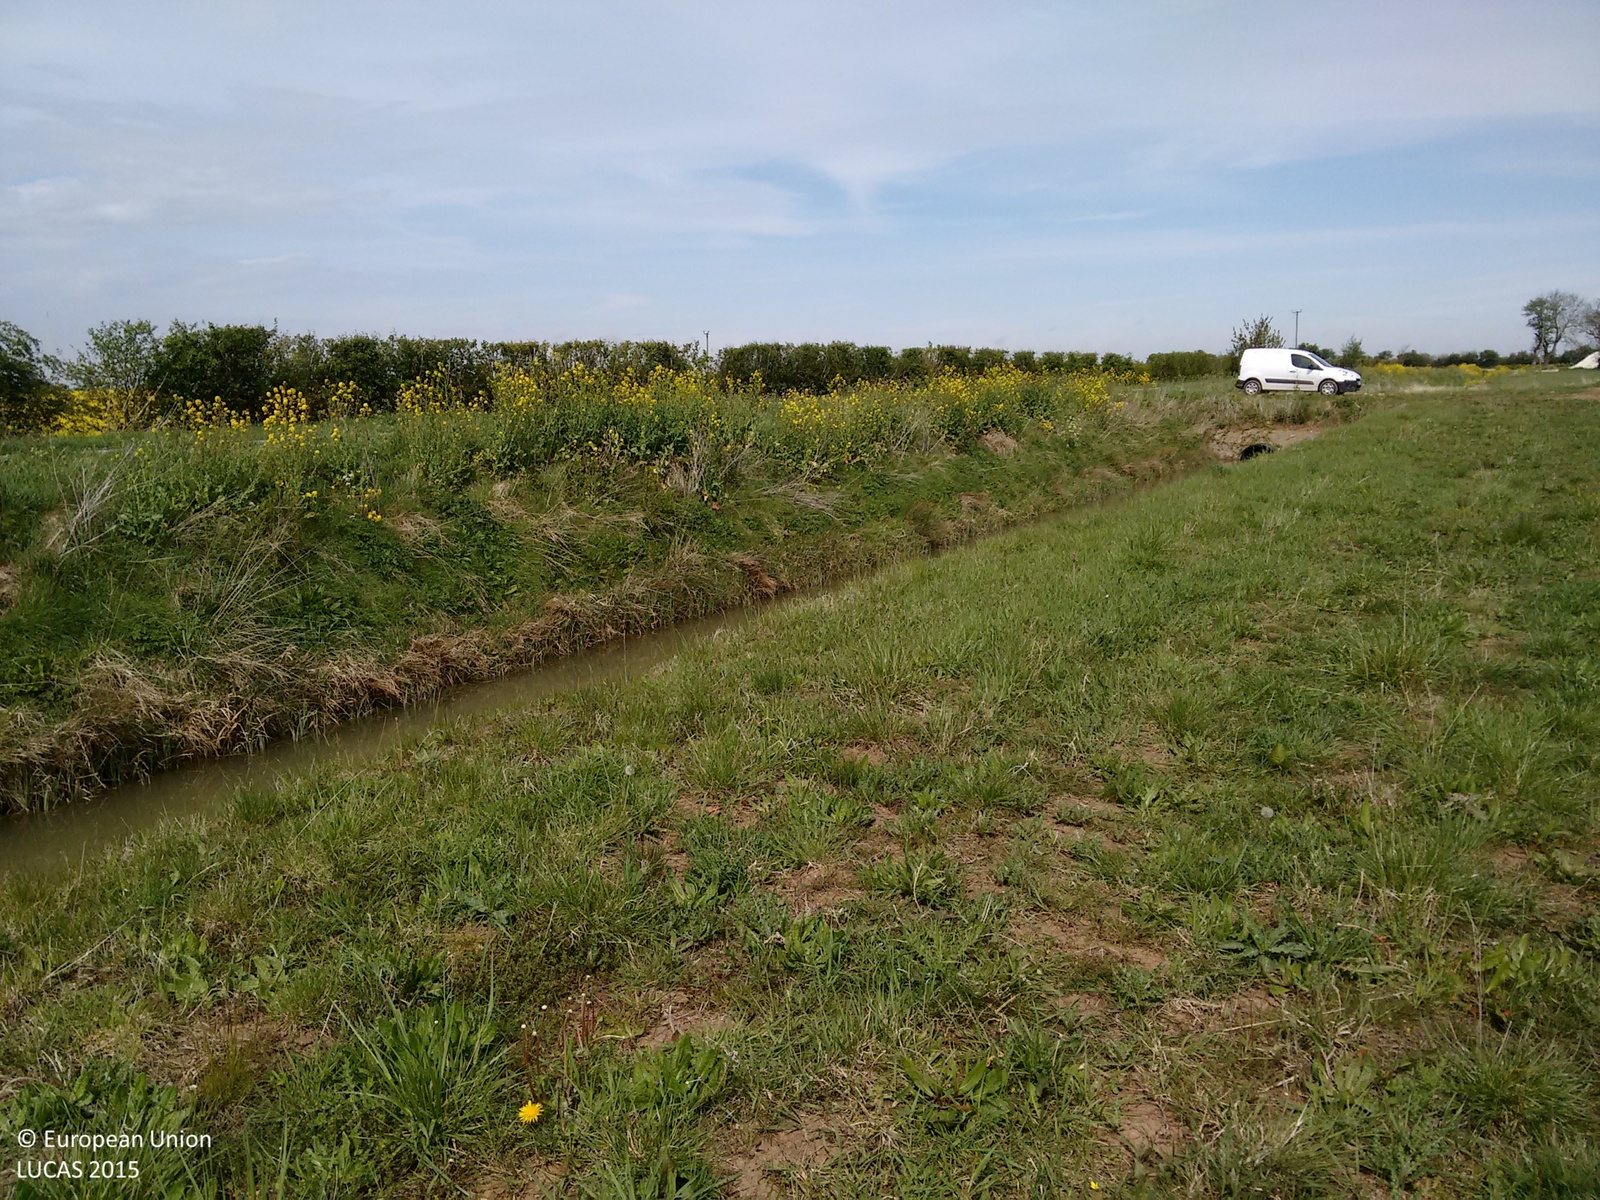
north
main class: Grassland
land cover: Grassland without tree/shrub cover
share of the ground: > 75 %
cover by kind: herbaceous plants 100 %
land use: Agriculture (excluding fallow land and kitchen gardens)
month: May
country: GB
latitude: 53.3446
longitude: 0.1614
